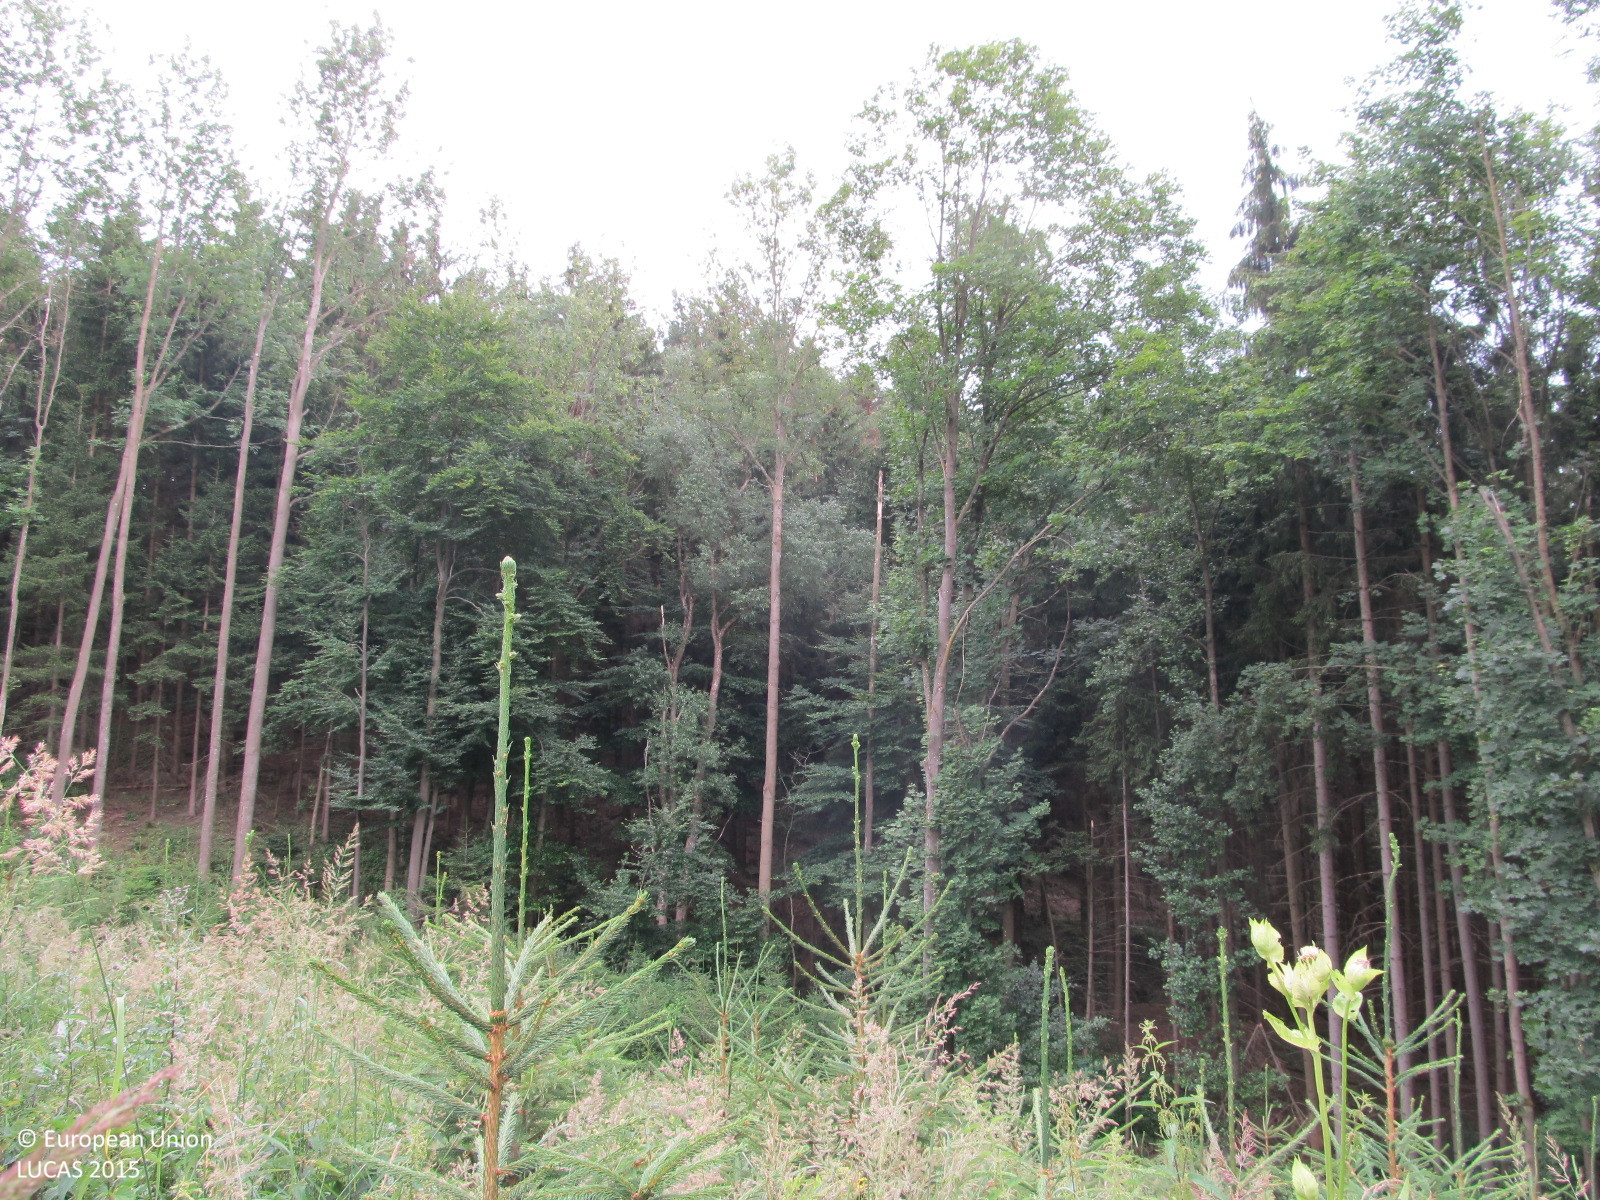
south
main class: Woodland
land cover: Spruce dominated coniferous woodland
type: hemiboreal forest and nemoral coniferous forest and mixed broadleaved-coniferous forest
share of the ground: > 75 %
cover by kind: coniferous forest trees 50 %, herbaceous plants 40 %, shrubs 10 %
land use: Forestry
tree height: < 5 m
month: July
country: AT
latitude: 48.4700
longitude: 15.3992
